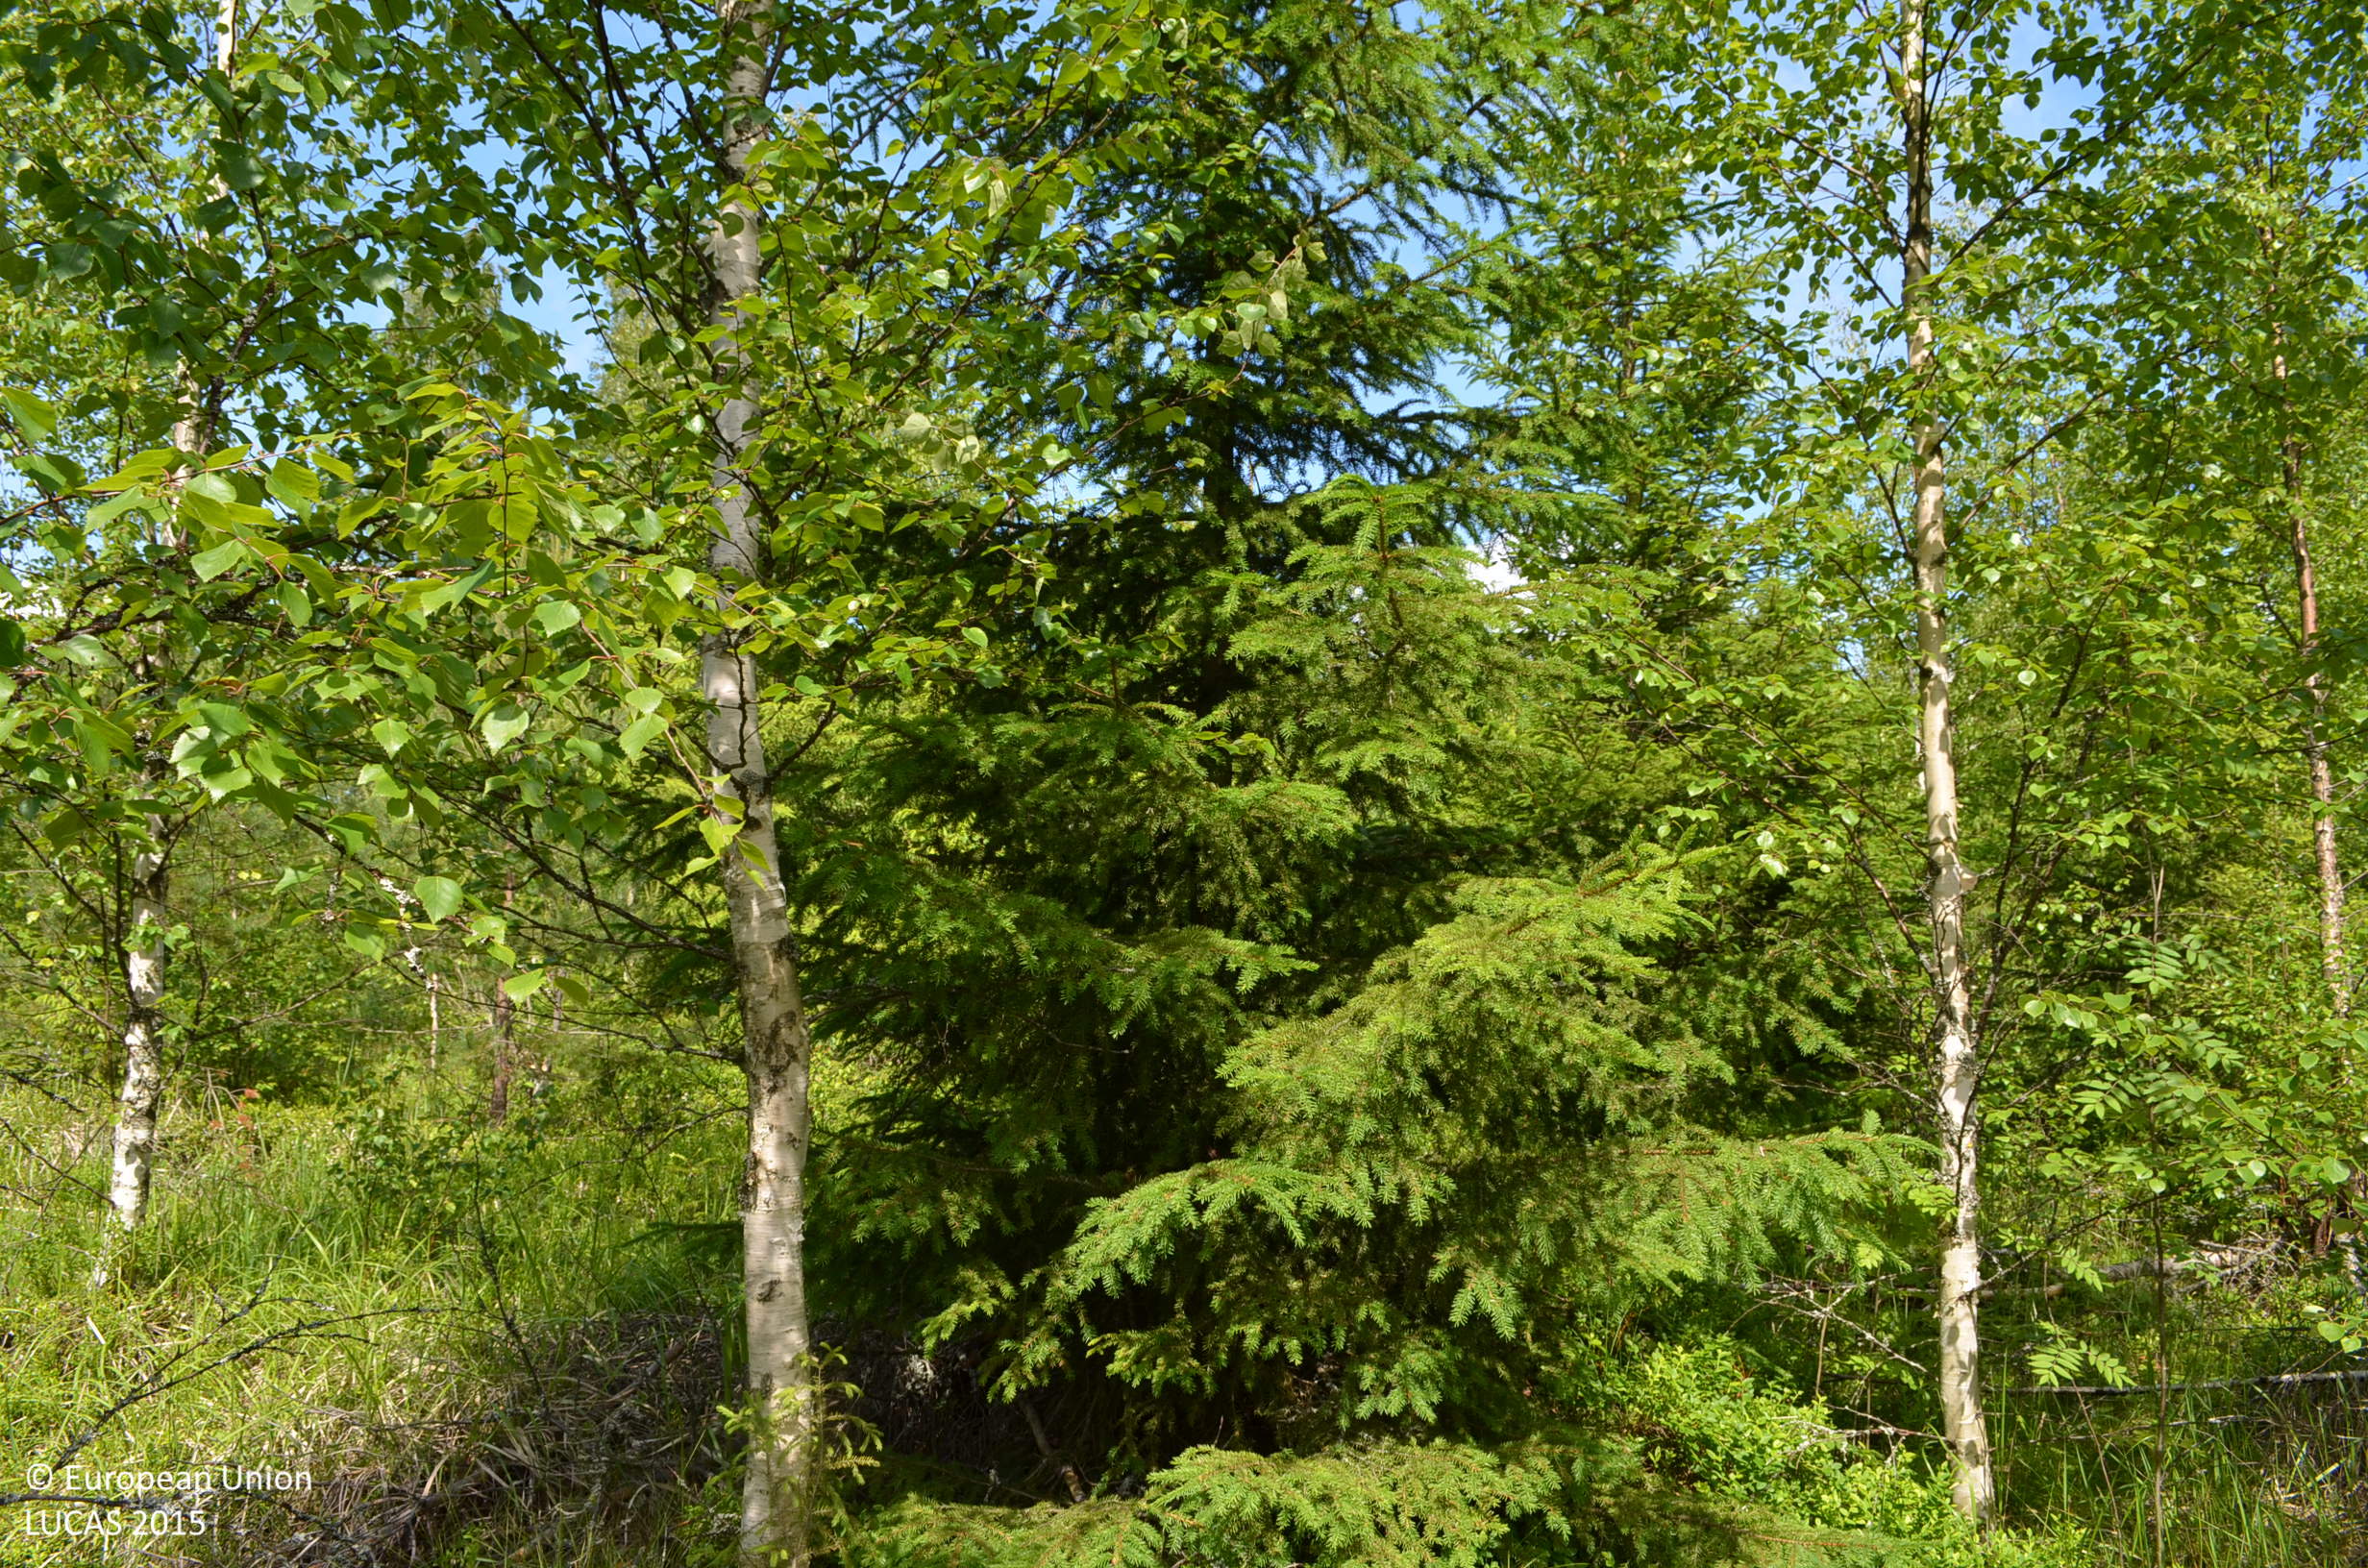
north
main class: Woodland
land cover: Other mixed woodland
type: boreal forest
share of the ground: > 75 %
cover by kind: broadleaved forest trees 40 %, coniferous forest trees 35 %, shrubs 20 %, herbaceous plants 5 %
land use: Forestry
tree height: < 5 m
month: June
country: FI
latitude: 61.6584
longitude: 23.2349
